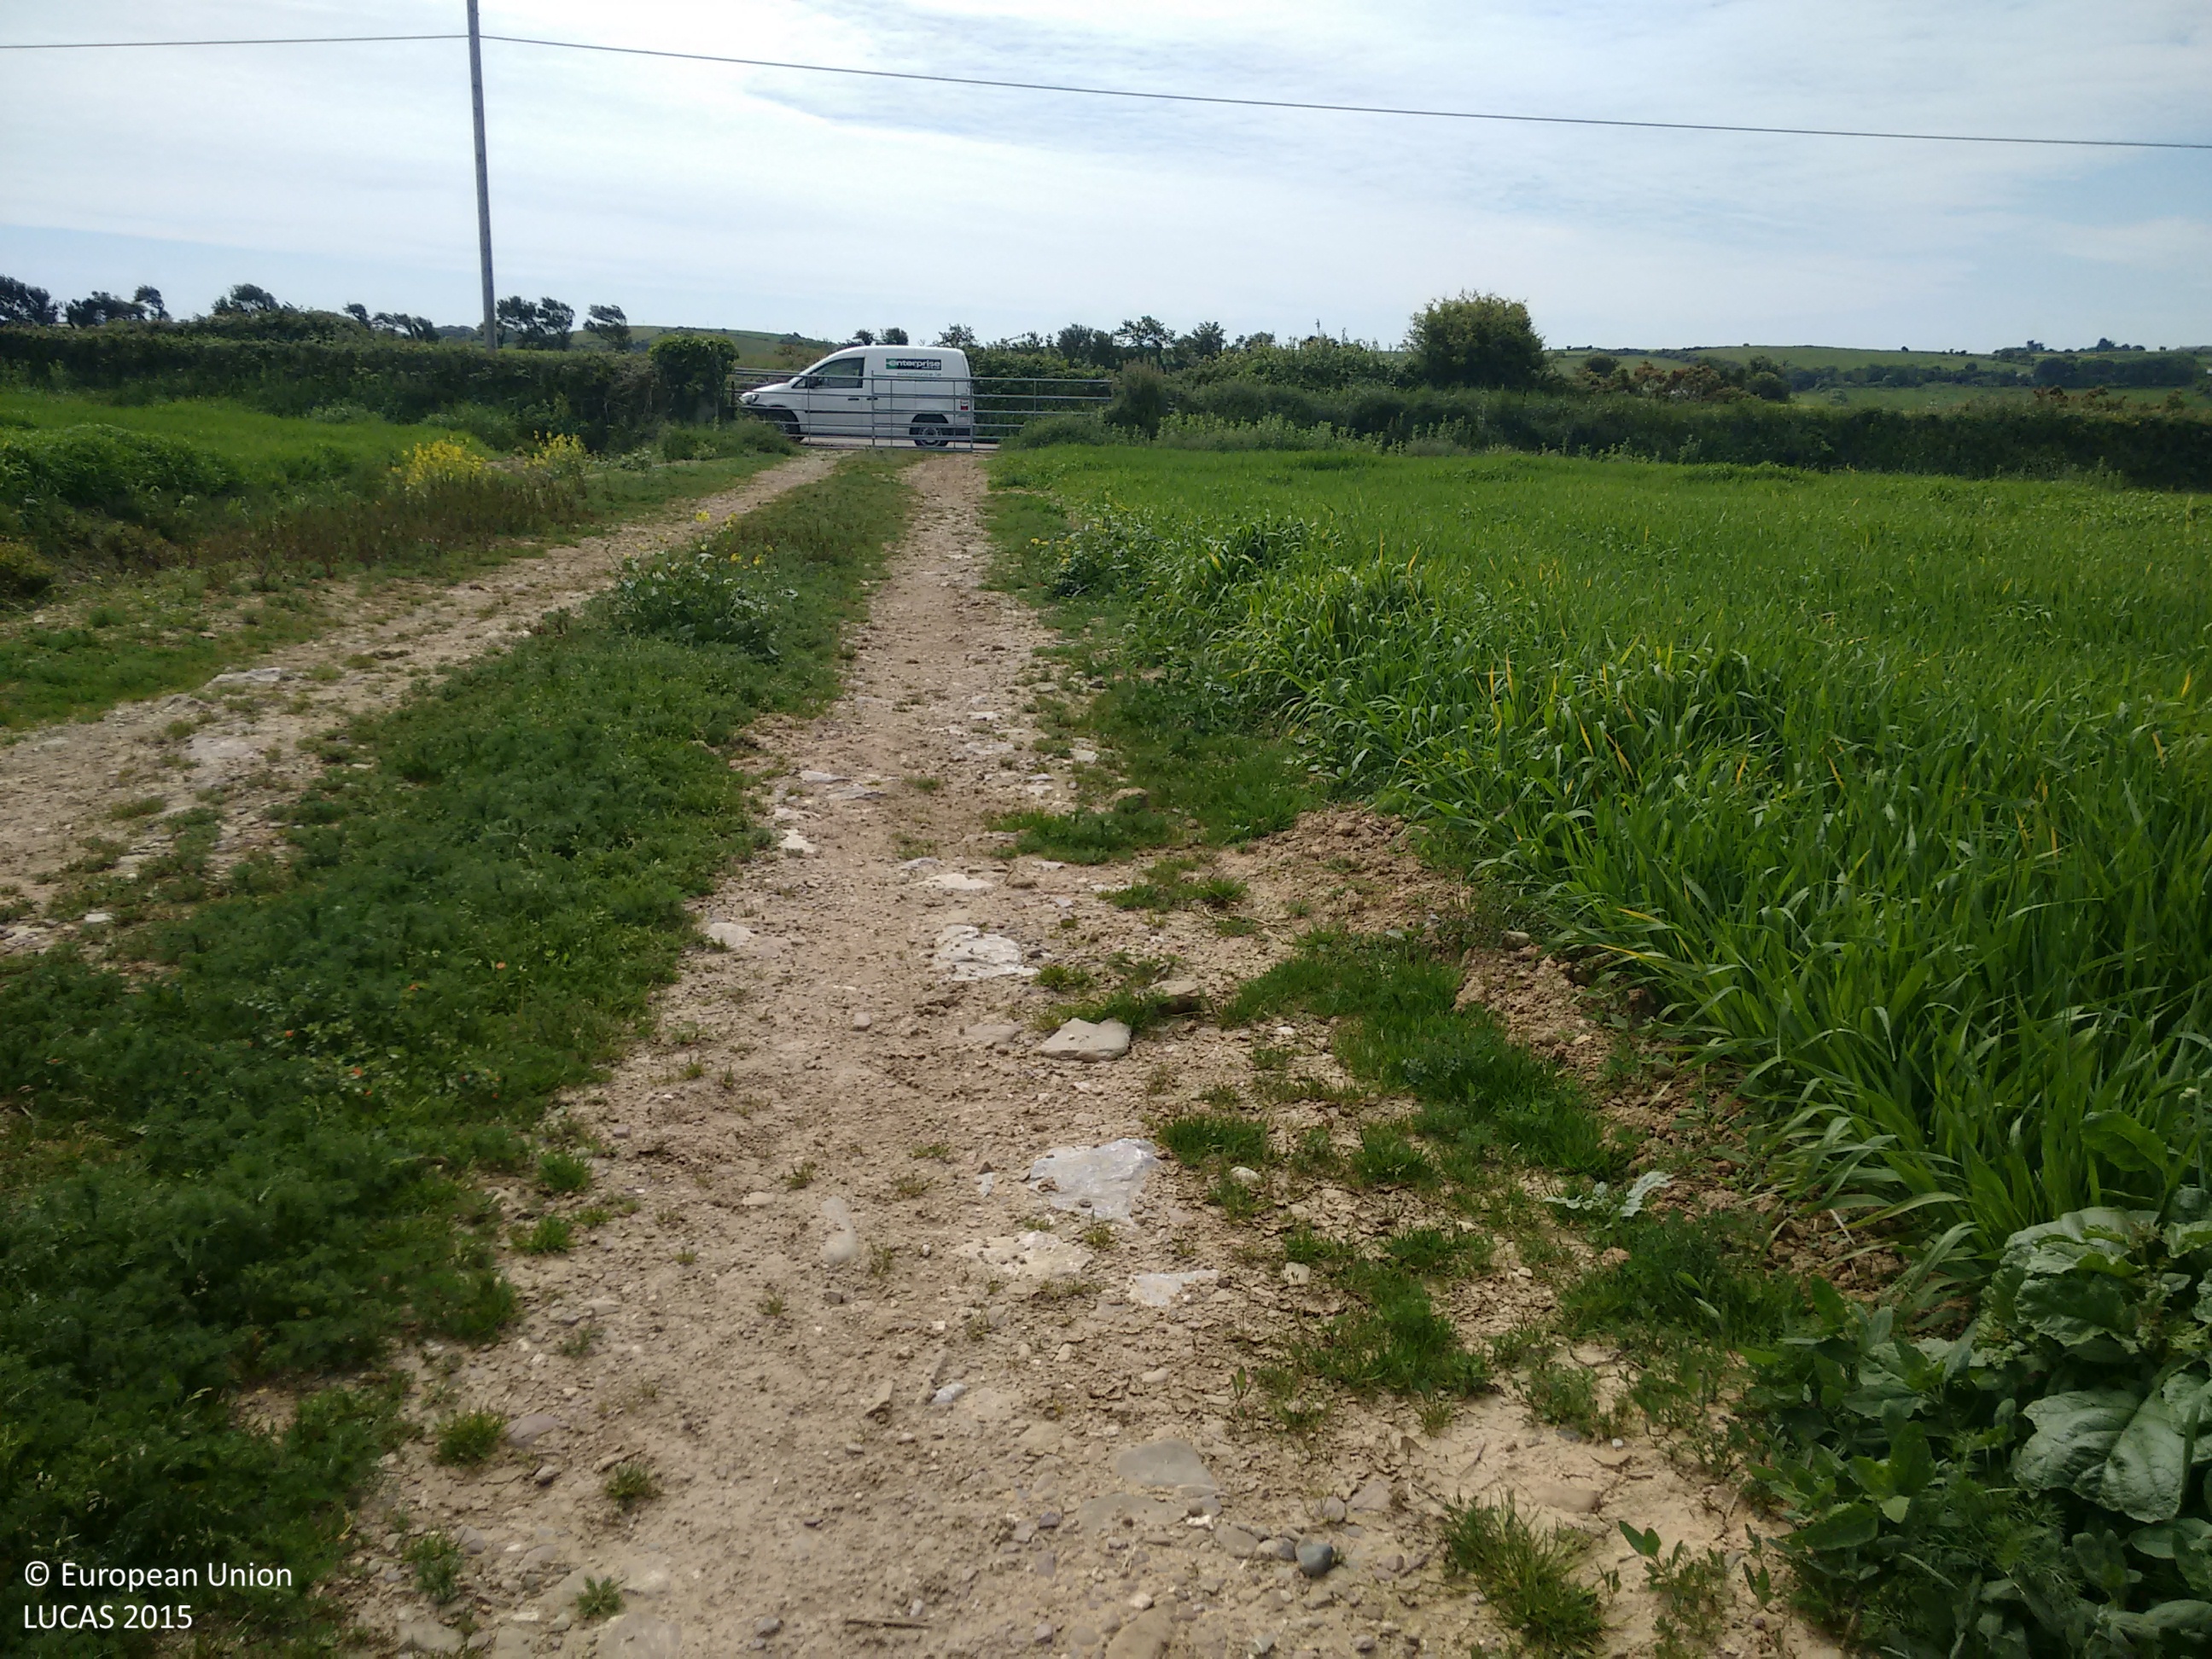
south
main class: Cropland
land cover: Barley
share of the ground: > 75 %
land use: Agriculture (excluding fallow land and kitchen gardens)
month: June
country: IE
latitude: 51.8444
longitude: -8.0462
